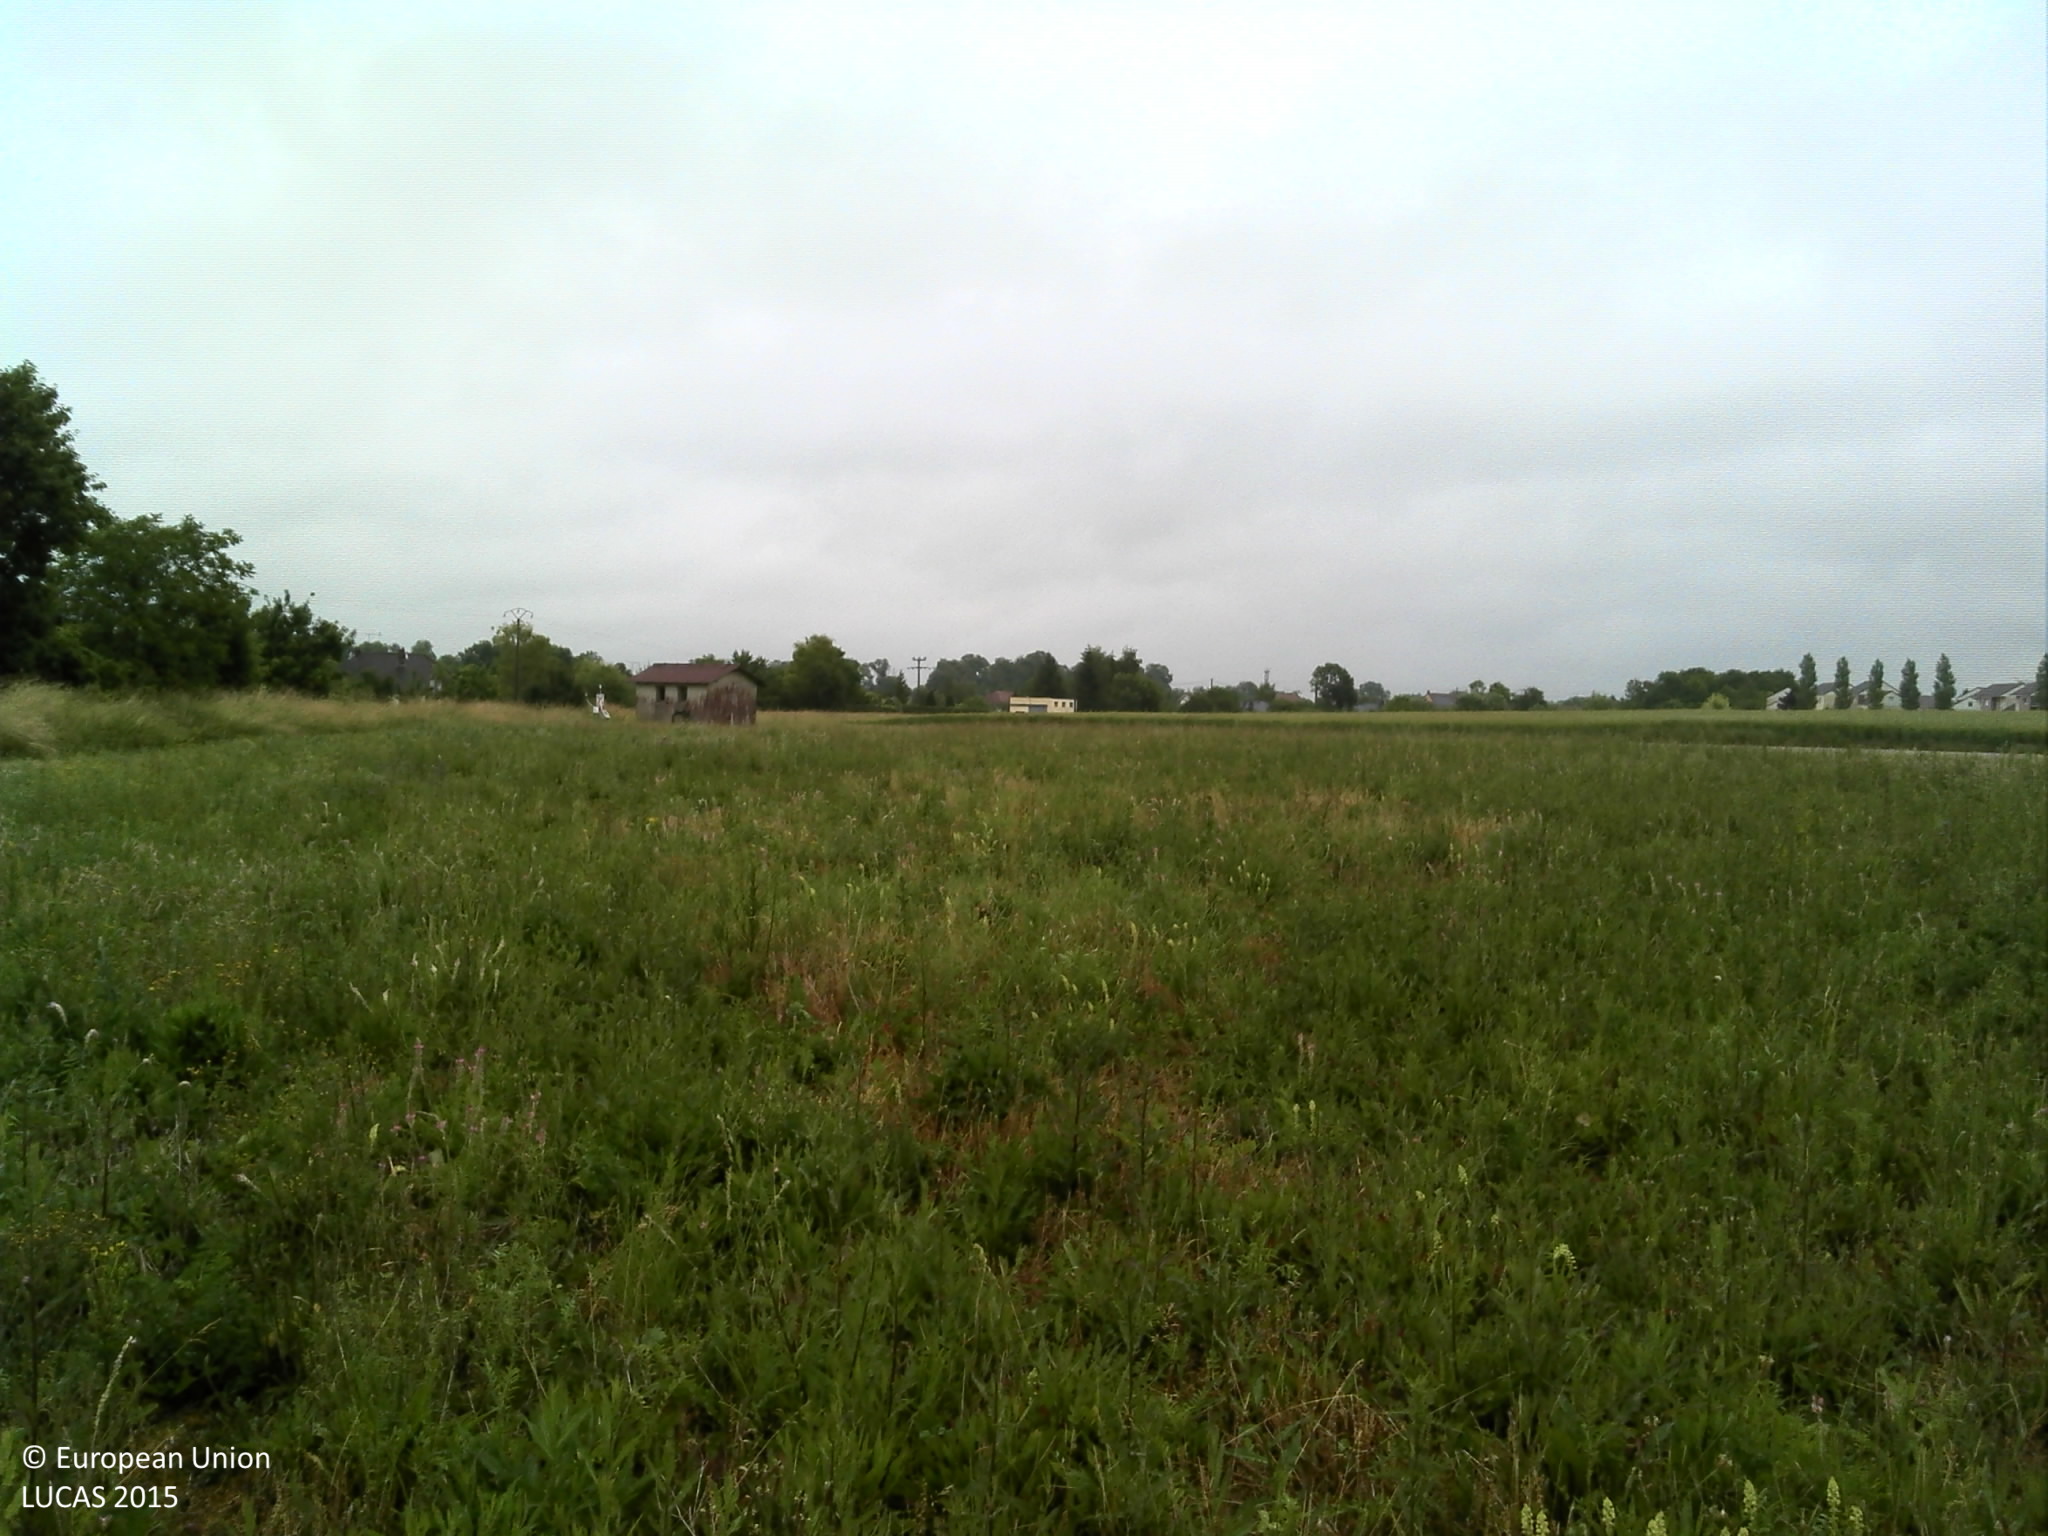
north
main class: Grassland
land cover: Spontaneously vegetated surfaces
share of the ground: > 75 %
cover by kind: herbaceous plants 80 %, lichens and mosses 10 %, consolidated bare surface 10 %
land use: Semi-natural and natural areas not in use
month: June
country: FR
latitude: 48.6660
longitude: 4.1983
